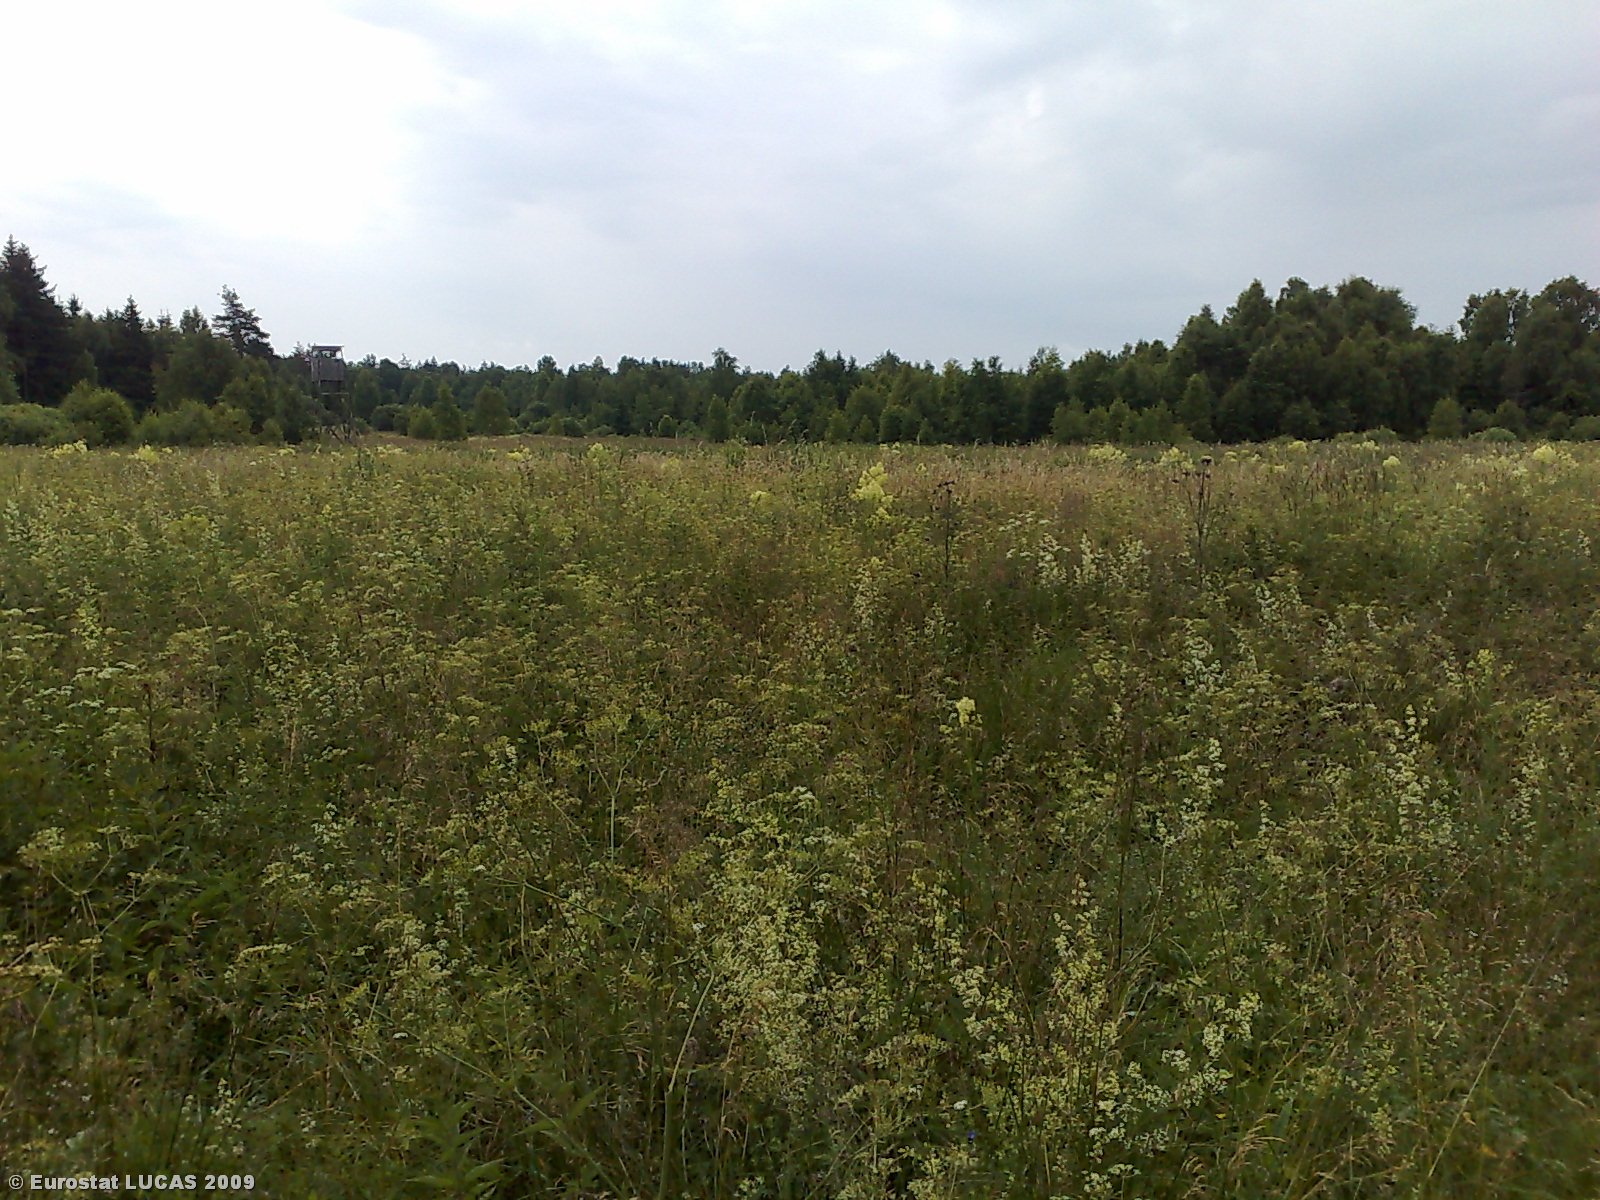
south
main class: Grassland
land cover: Grassland with sparse tree/shrub cover
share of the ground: > 75 %
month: July
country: LT
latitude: 55.5939
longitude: 22.8407
